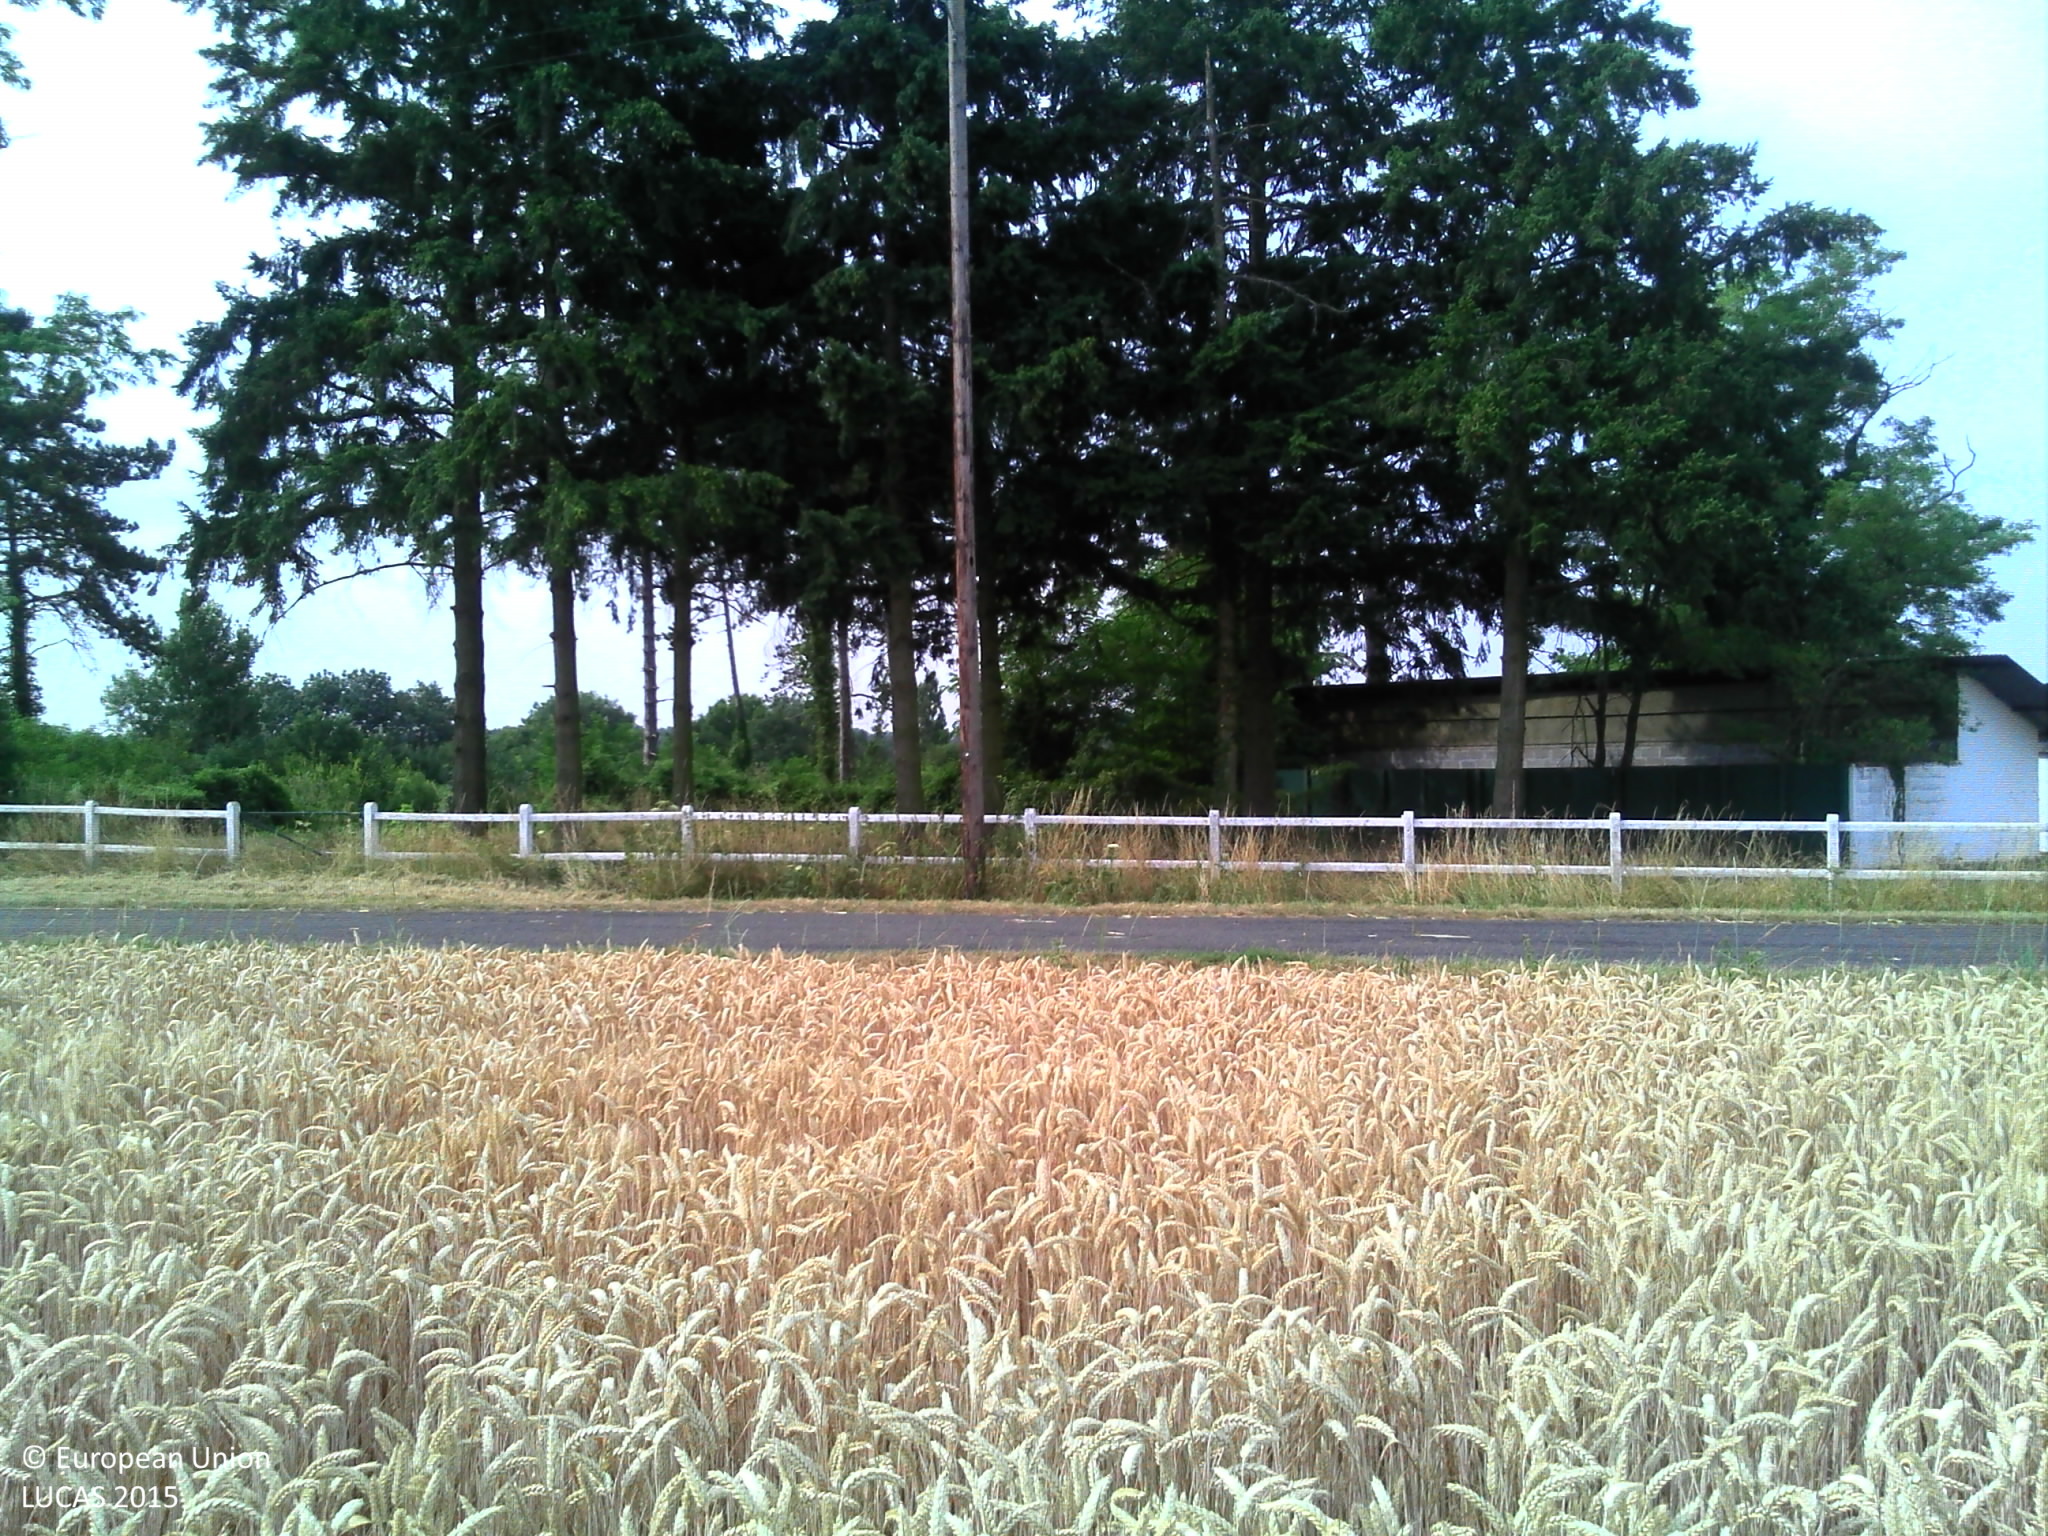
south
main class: Cropland
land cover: Common wheat
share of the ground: > 75 %
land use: Agriculture (excluding fallow land and kitchen gardens)
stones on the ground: 10 - 25 %
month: July
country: FR
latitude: 47.6638
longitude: 2.8154
